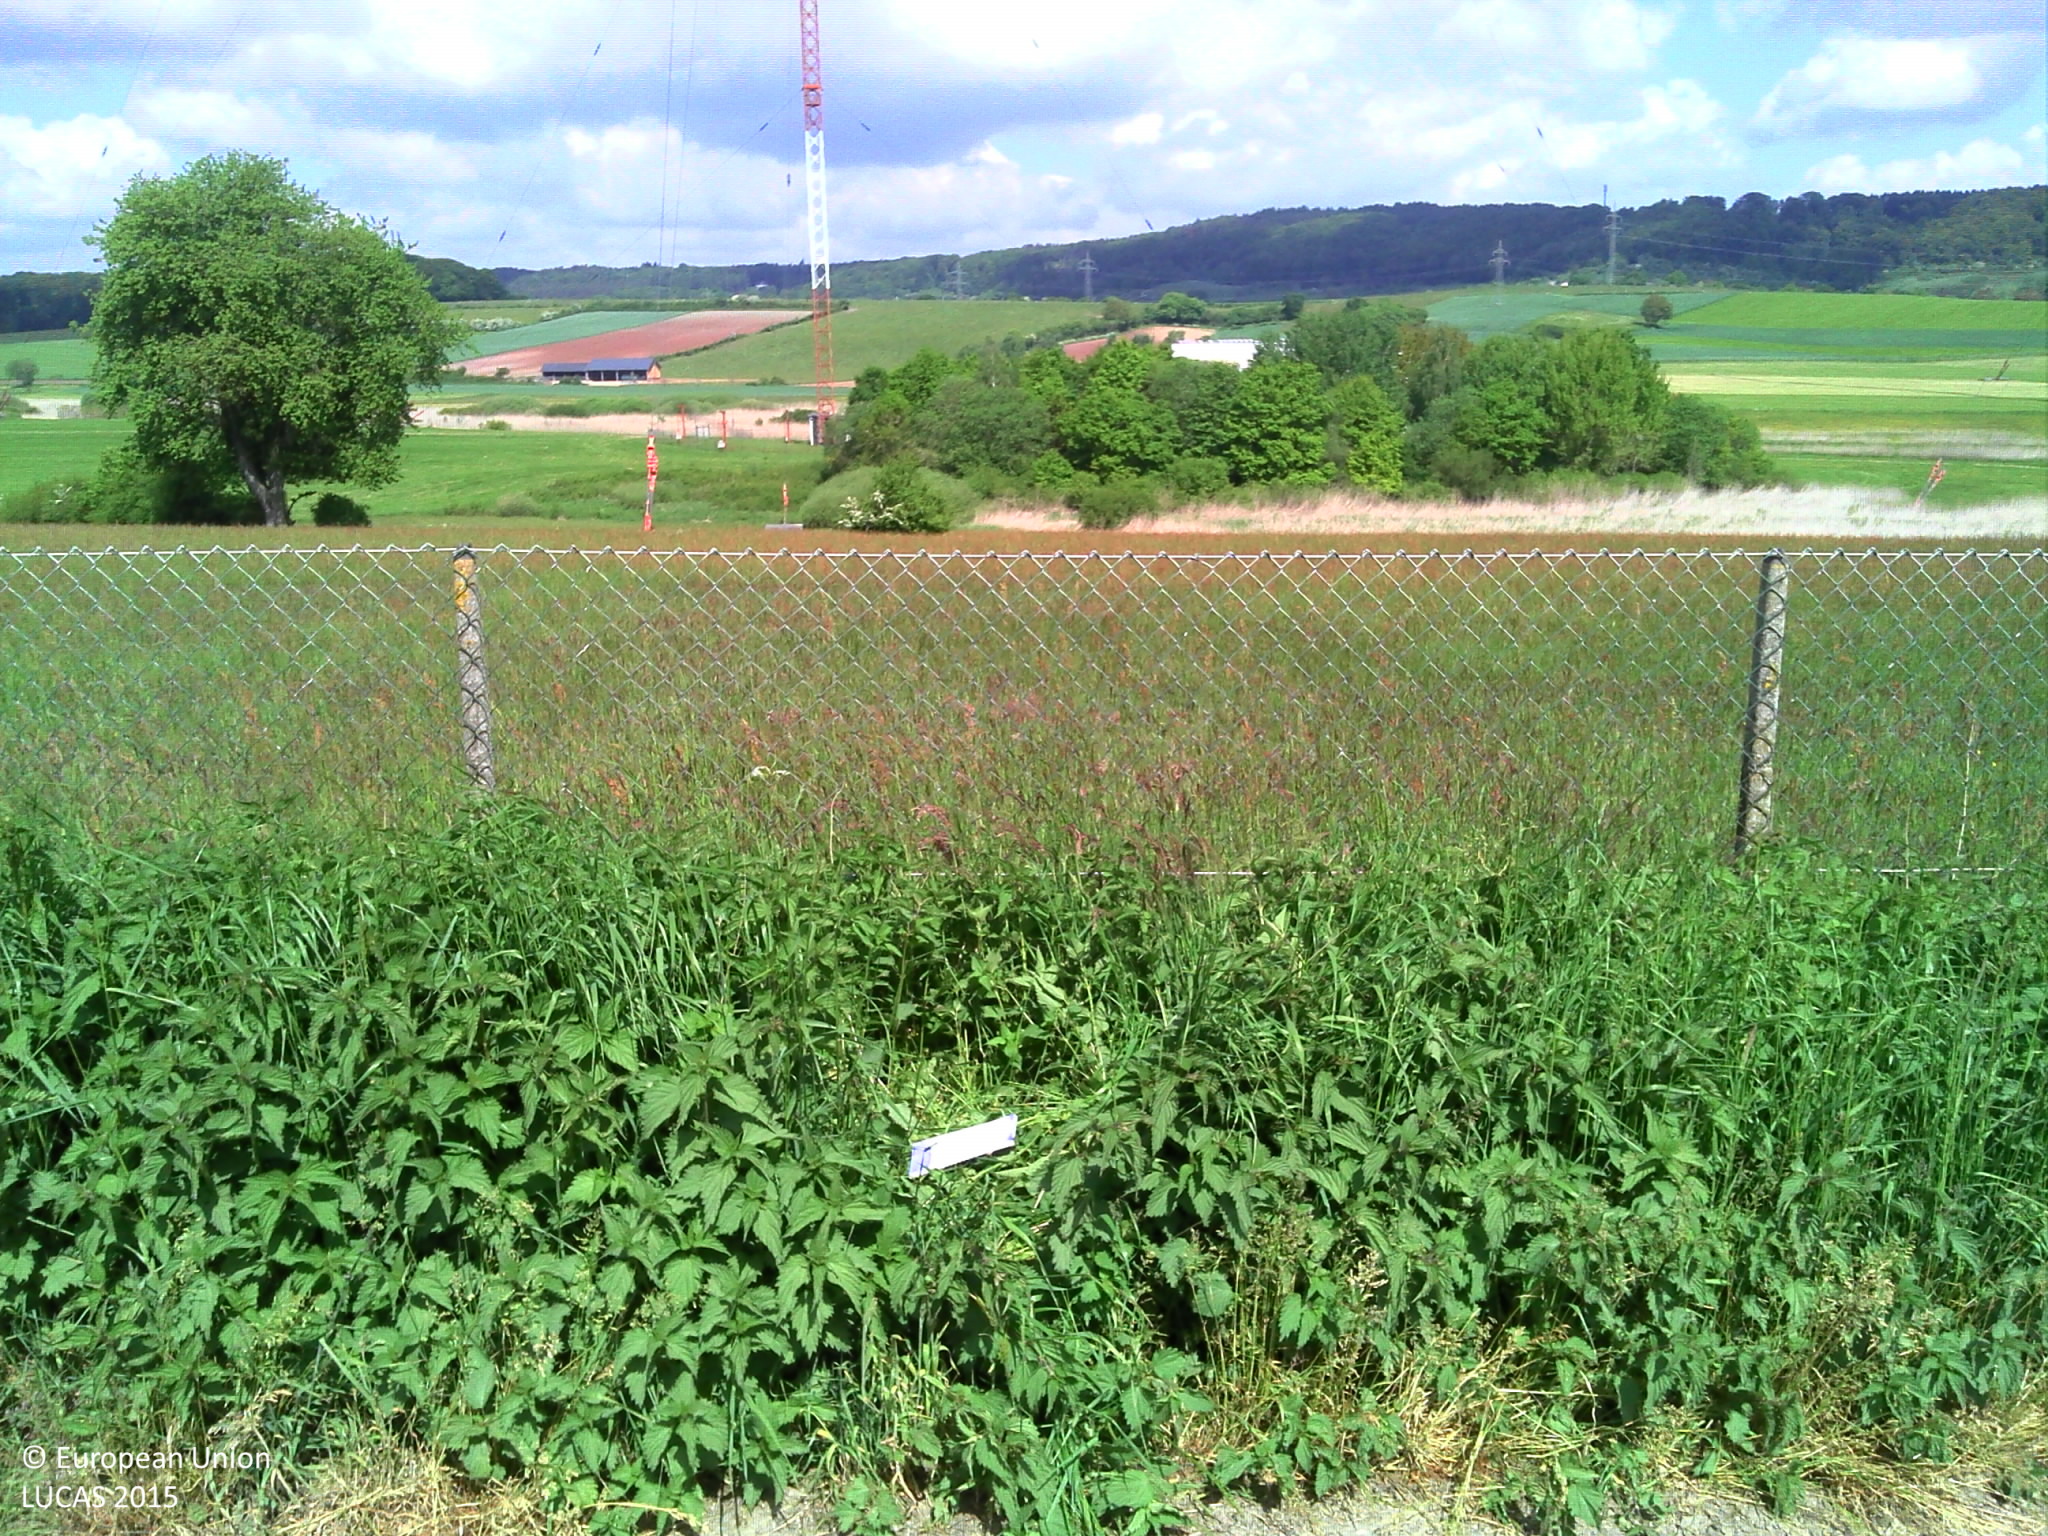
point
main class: Grassland
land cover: Grassland without tree/shrub cover
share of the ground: > 75 %
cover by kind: herbaceous plants 100 %
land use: Agriculture (excluding fallow land and kitchen gardens)
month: May
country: LU
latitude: 49.7289
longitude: 6.3232
